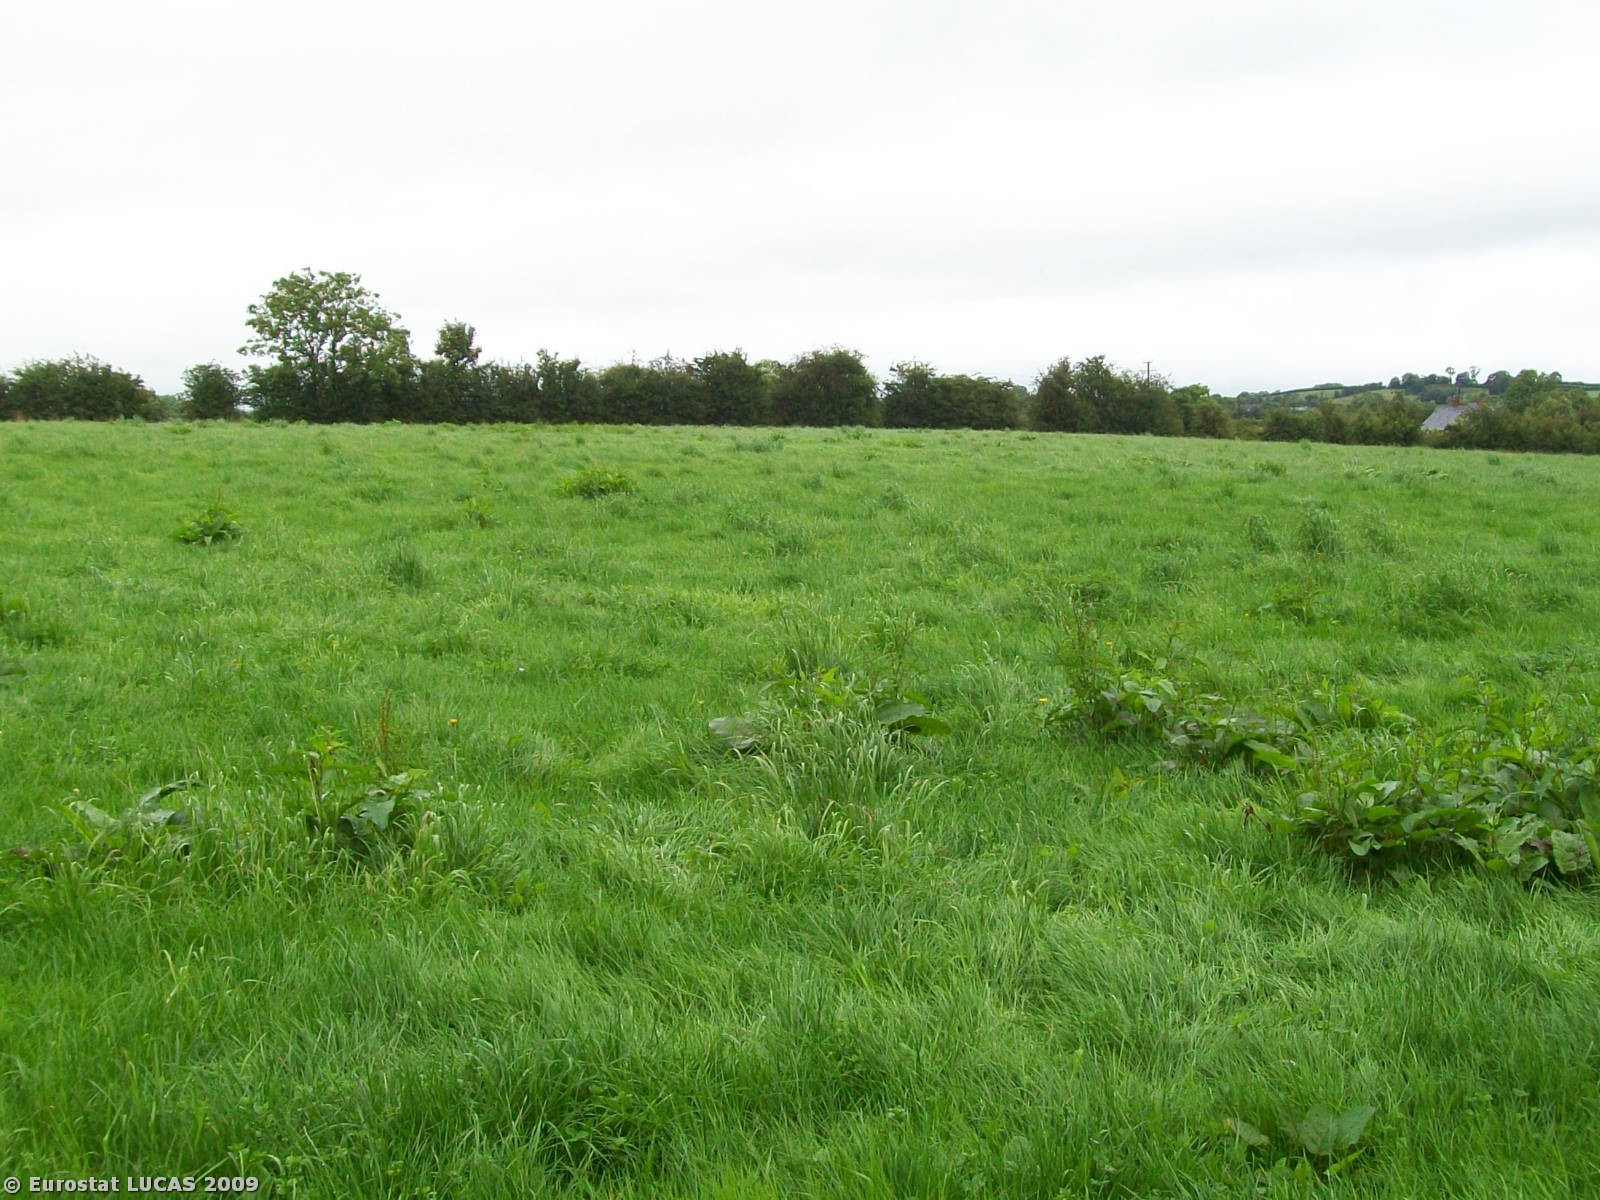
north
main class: Grassland
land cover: Grassland without tree/shrub cover
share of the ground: > 75 %
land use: Agriculture (excluding fallow land and kitchen gardens)
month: August
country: GB
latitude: 54.6438
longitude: -6.1201
